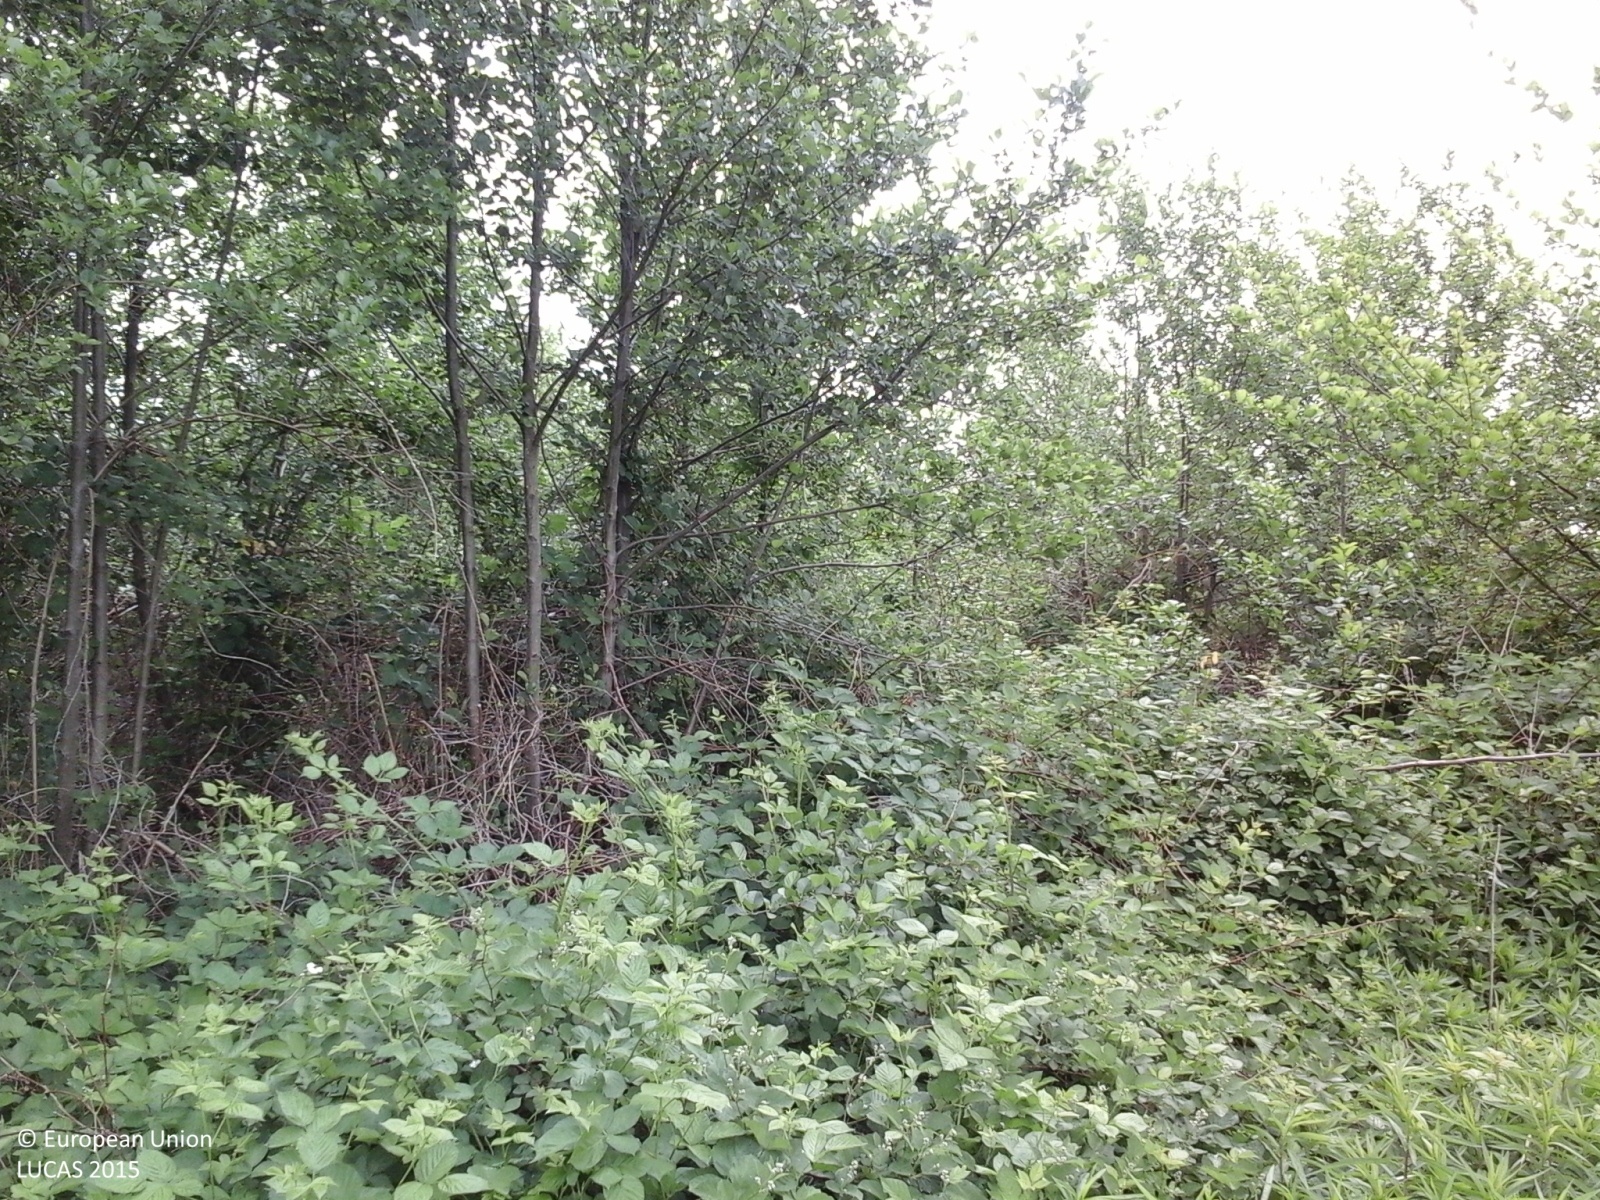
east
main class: Woodland
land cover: Broadleaved woodland
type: thermophilous deciduous forest
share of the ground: > 75 %
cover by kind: broadleaved forest trees 100 %
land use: Forestry
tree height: > 5 m
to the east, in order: Broadleaved woodland; Shrubland with sparse tree cover; Broadleaved woodland; Tracks; Grass margins
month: May
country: IT
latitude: 45.5460
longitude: 8.3760
